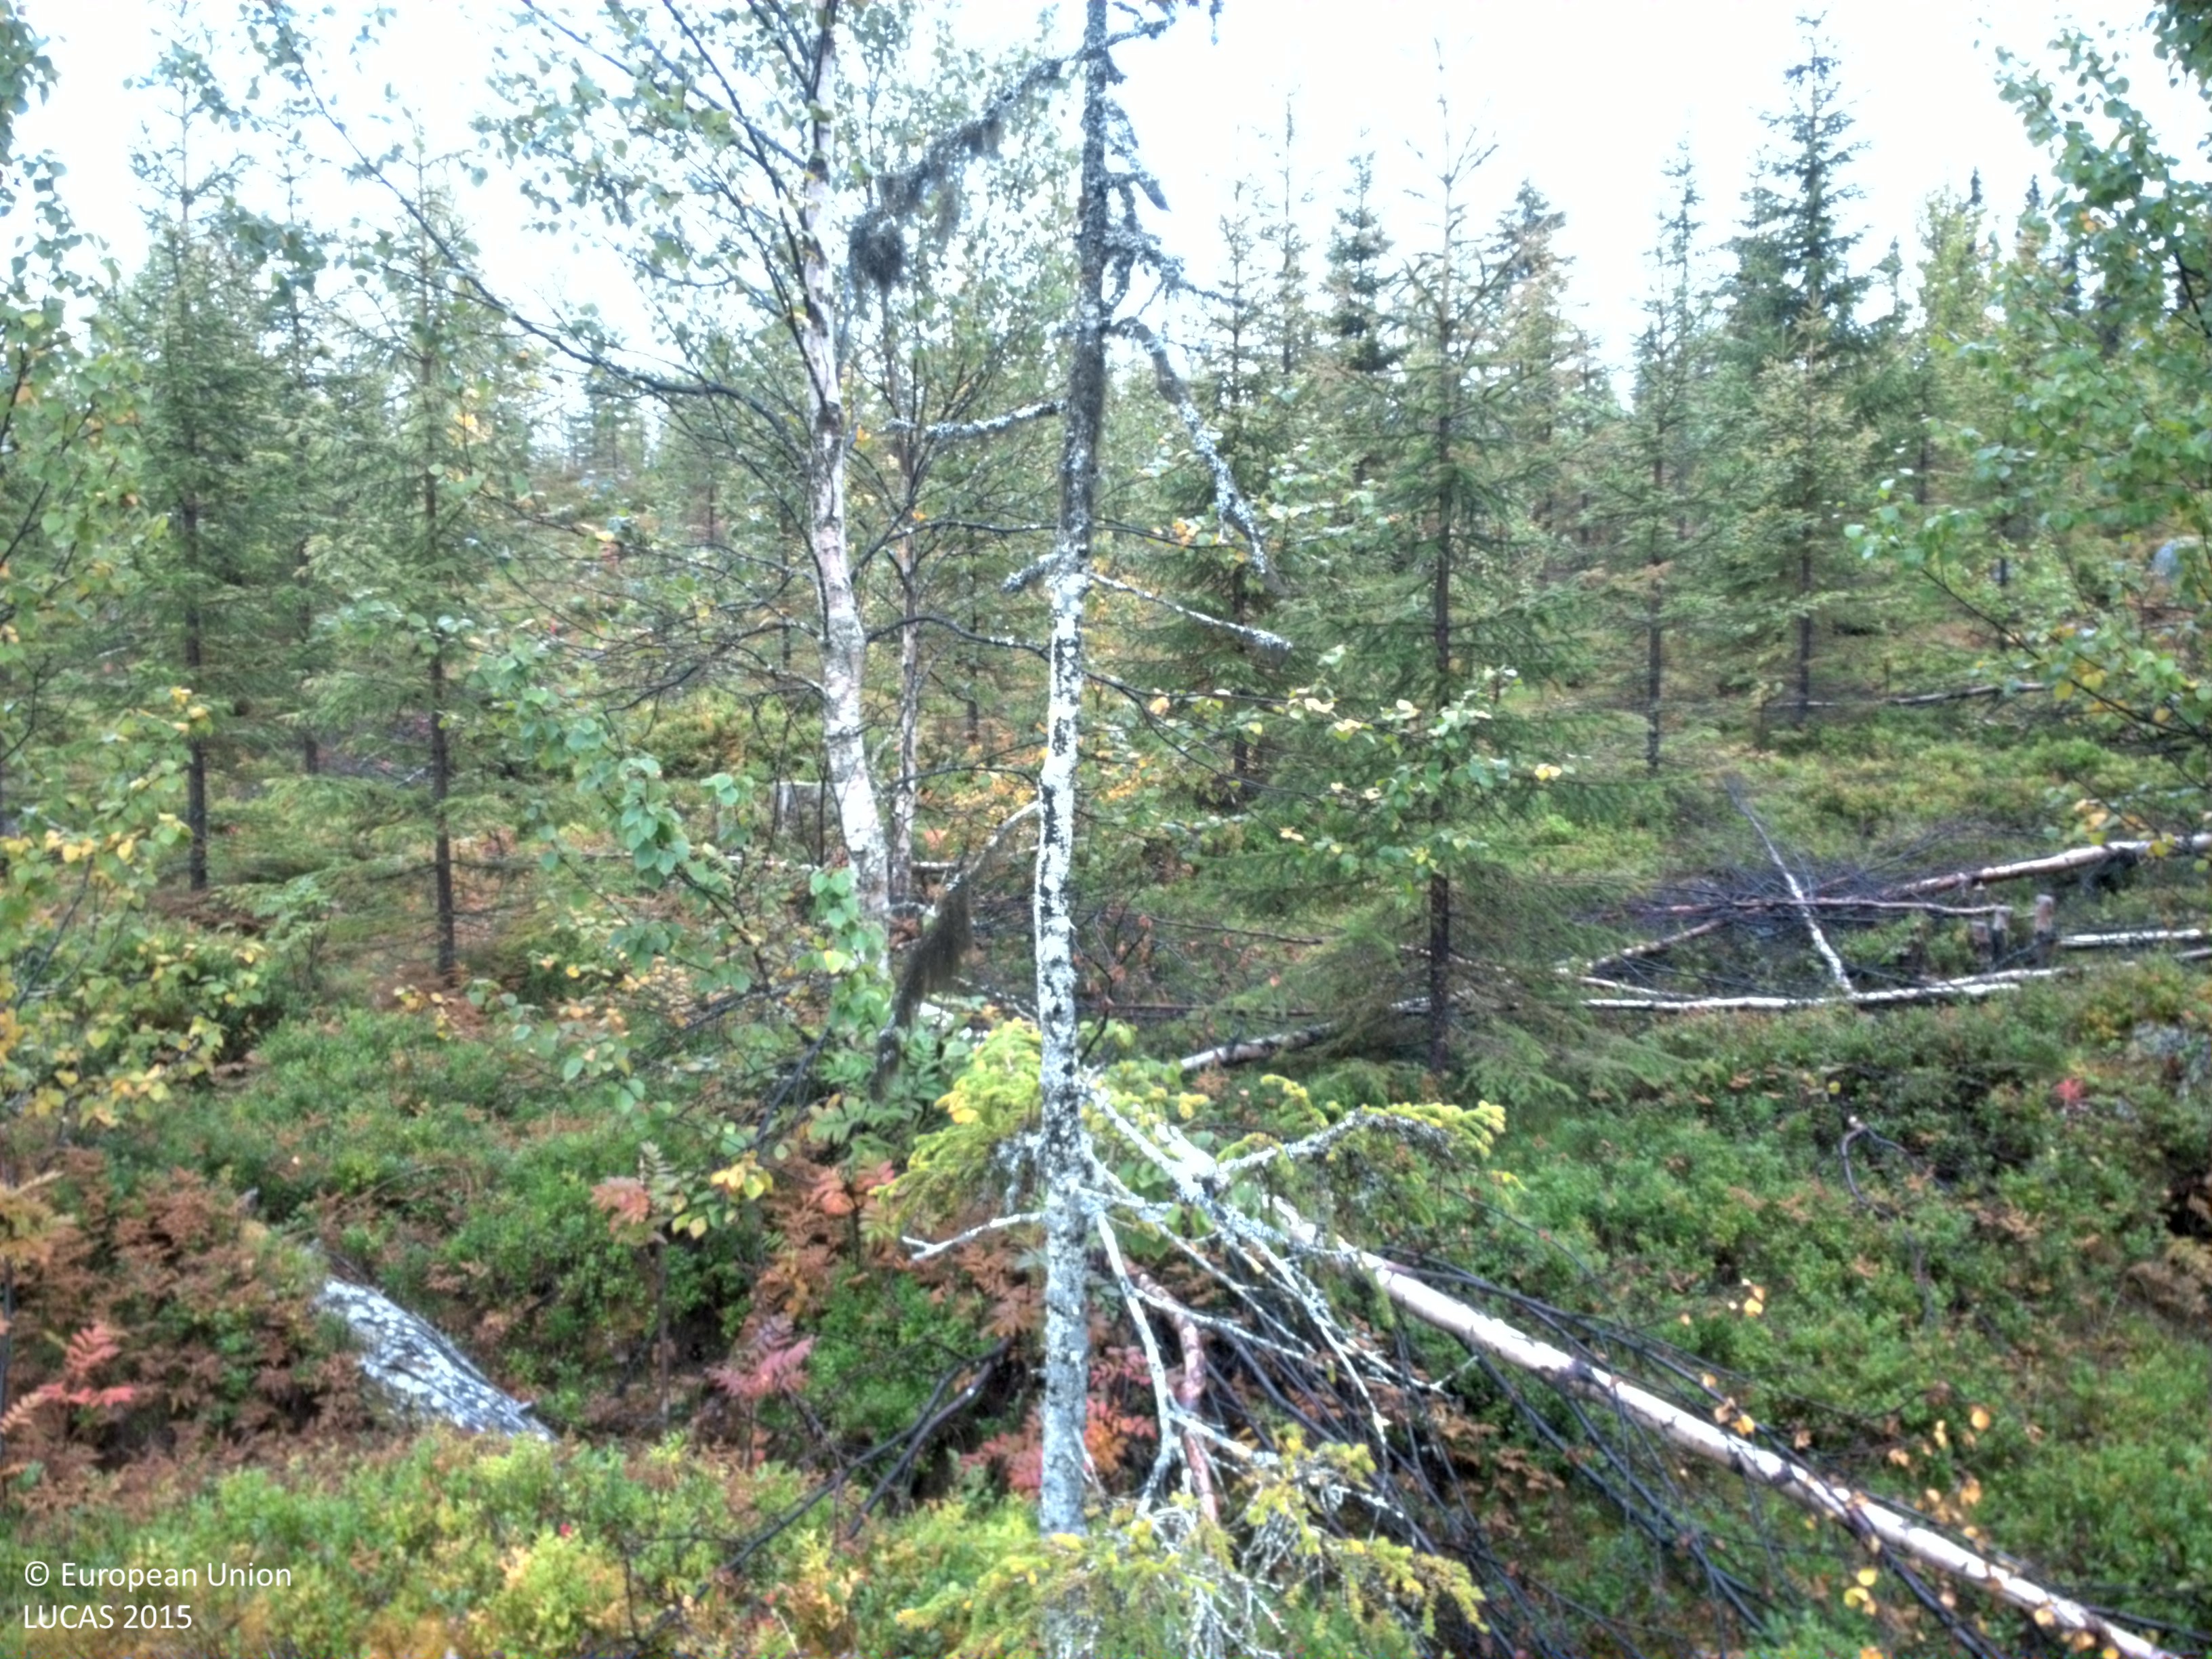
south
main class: Woodland
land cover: Spruce dominated mixed woodland
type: boreal forest
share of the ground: 10 - 25 %
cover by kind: shrubs 50 %, lichens and mosses 20 %, herbaceous plants 15 %, coniferous forest trees 10 %, broadleaved forest trees 5 %
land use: Forestry
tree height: > 5 m
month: September
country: SE
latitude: 65.1838
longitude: 16.6468
